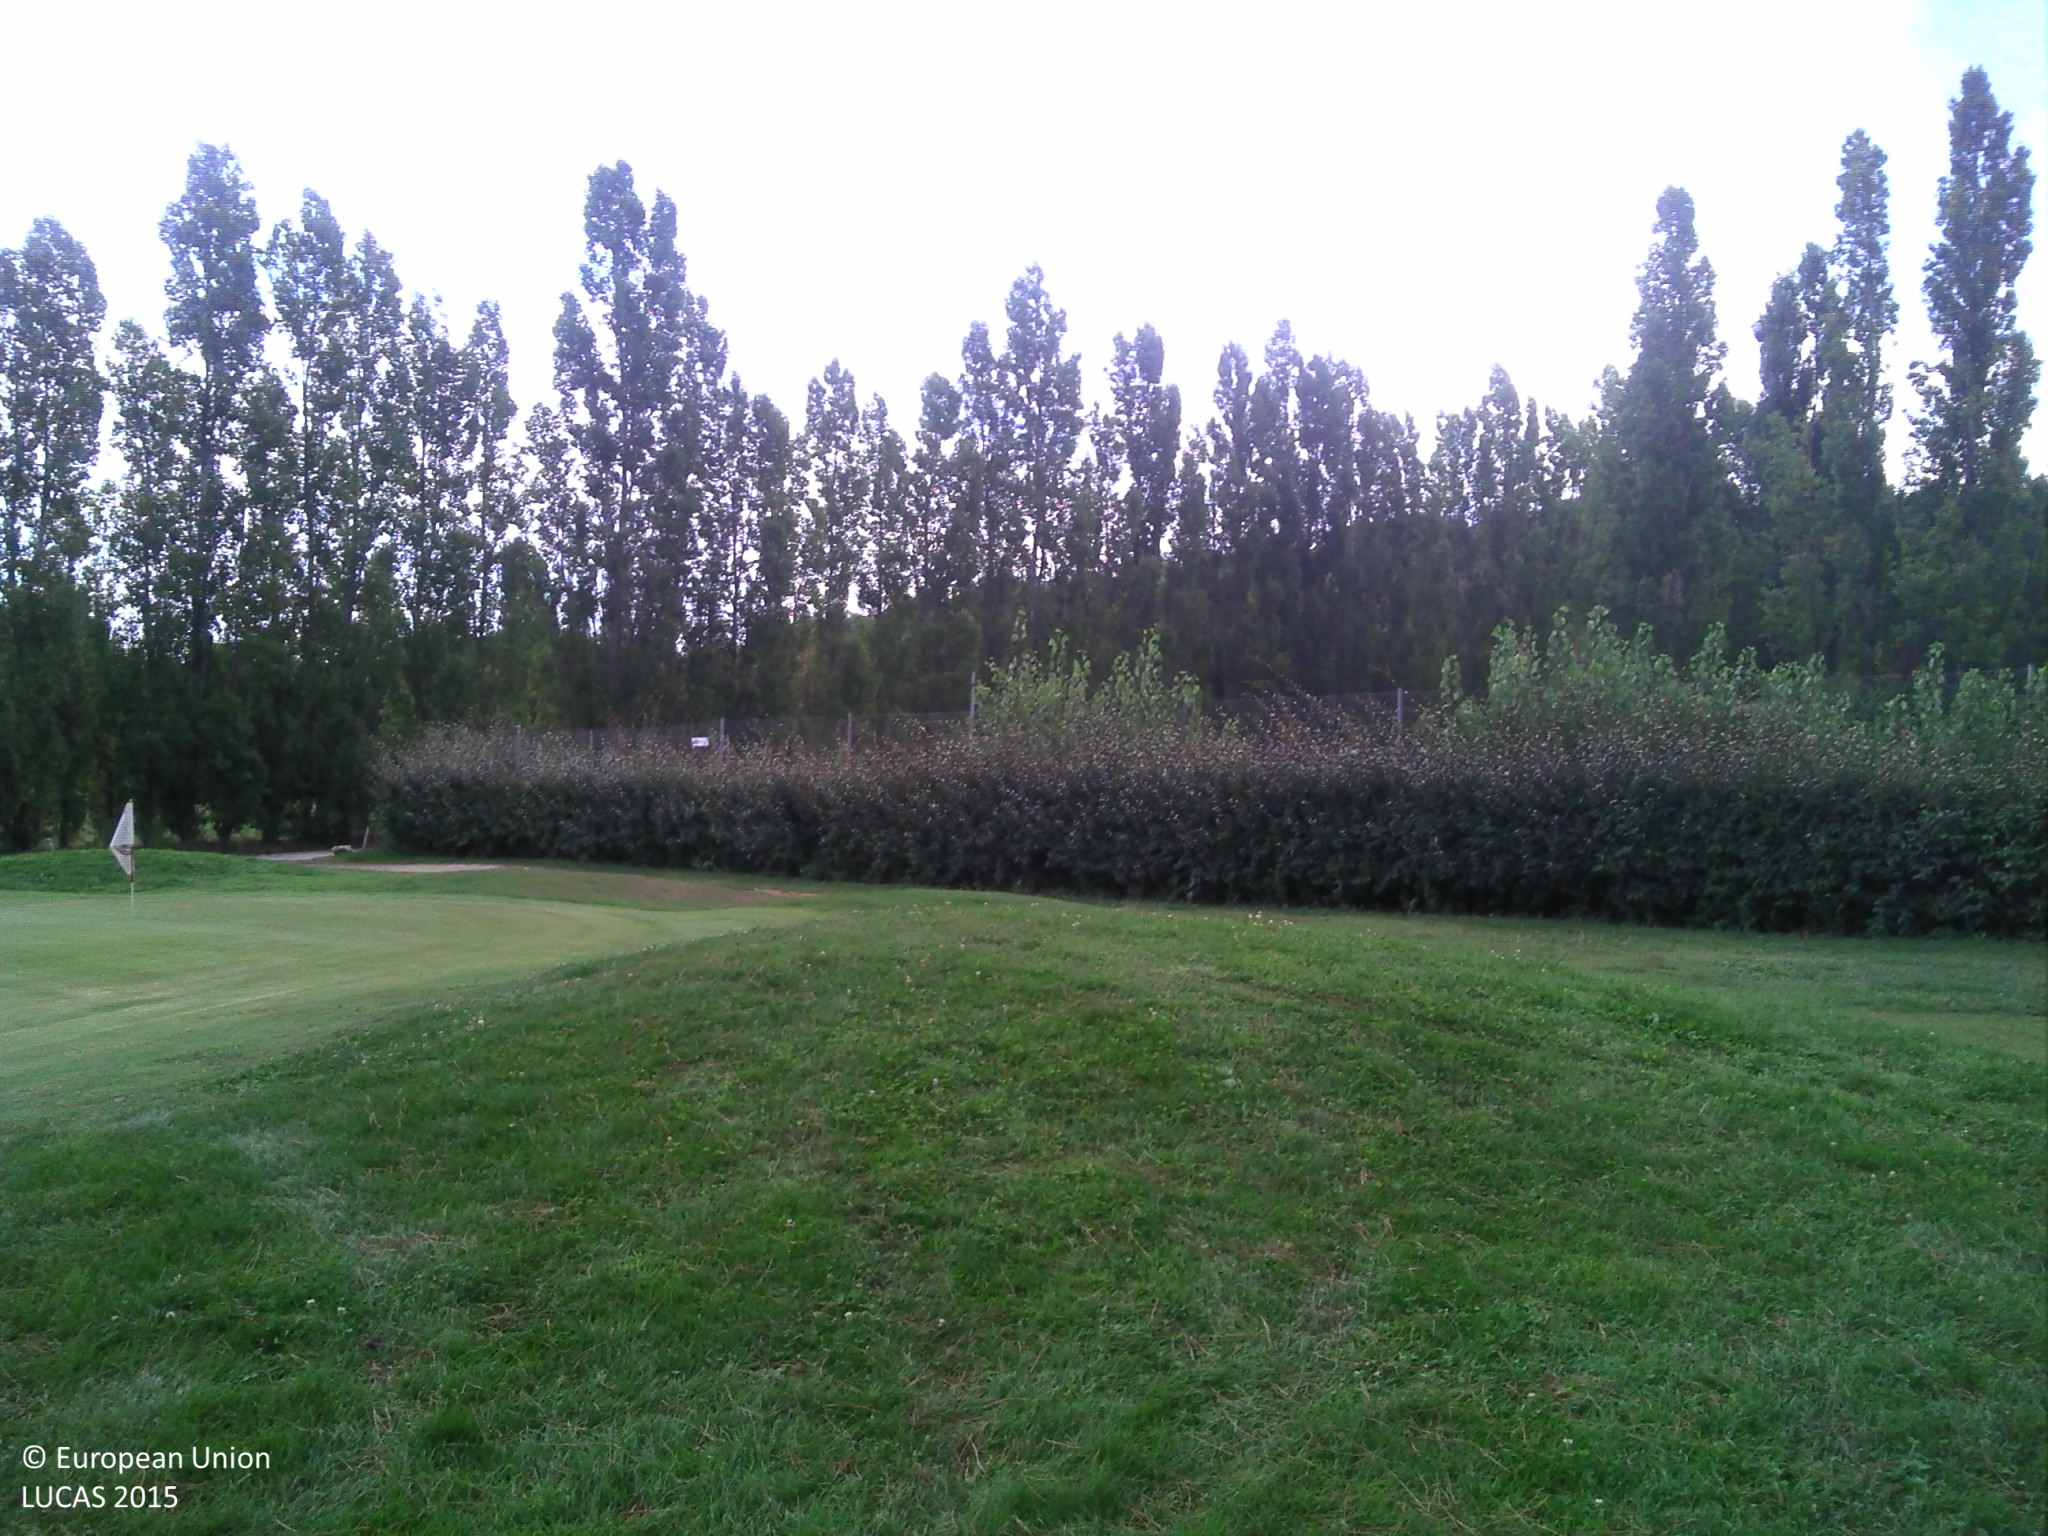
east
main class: Grassland
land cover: Grassland with sparse tree/shrub cover
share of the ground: > 75 %
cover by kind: herbaceous plants 85 %, unconsolidated bare surface 10 %, broadleaved forest trees 5 %
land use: Sport
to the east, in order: Grassland with sparse tree/shrub cover; Grassland without tree/shrub cover; Tracks; Electric lines; Managed hedges; Fences; Grassland without tree/shrub cover; Fences; Lines of trees; Grassland without tree/shrub cover; Lines of trees; Grassland without tree/shrub cover; Shrubland without tree cover; Tracks; Broadleaved woodland; Durum wheat
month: August
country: FR
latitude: 43.4622
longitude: 5.5973
